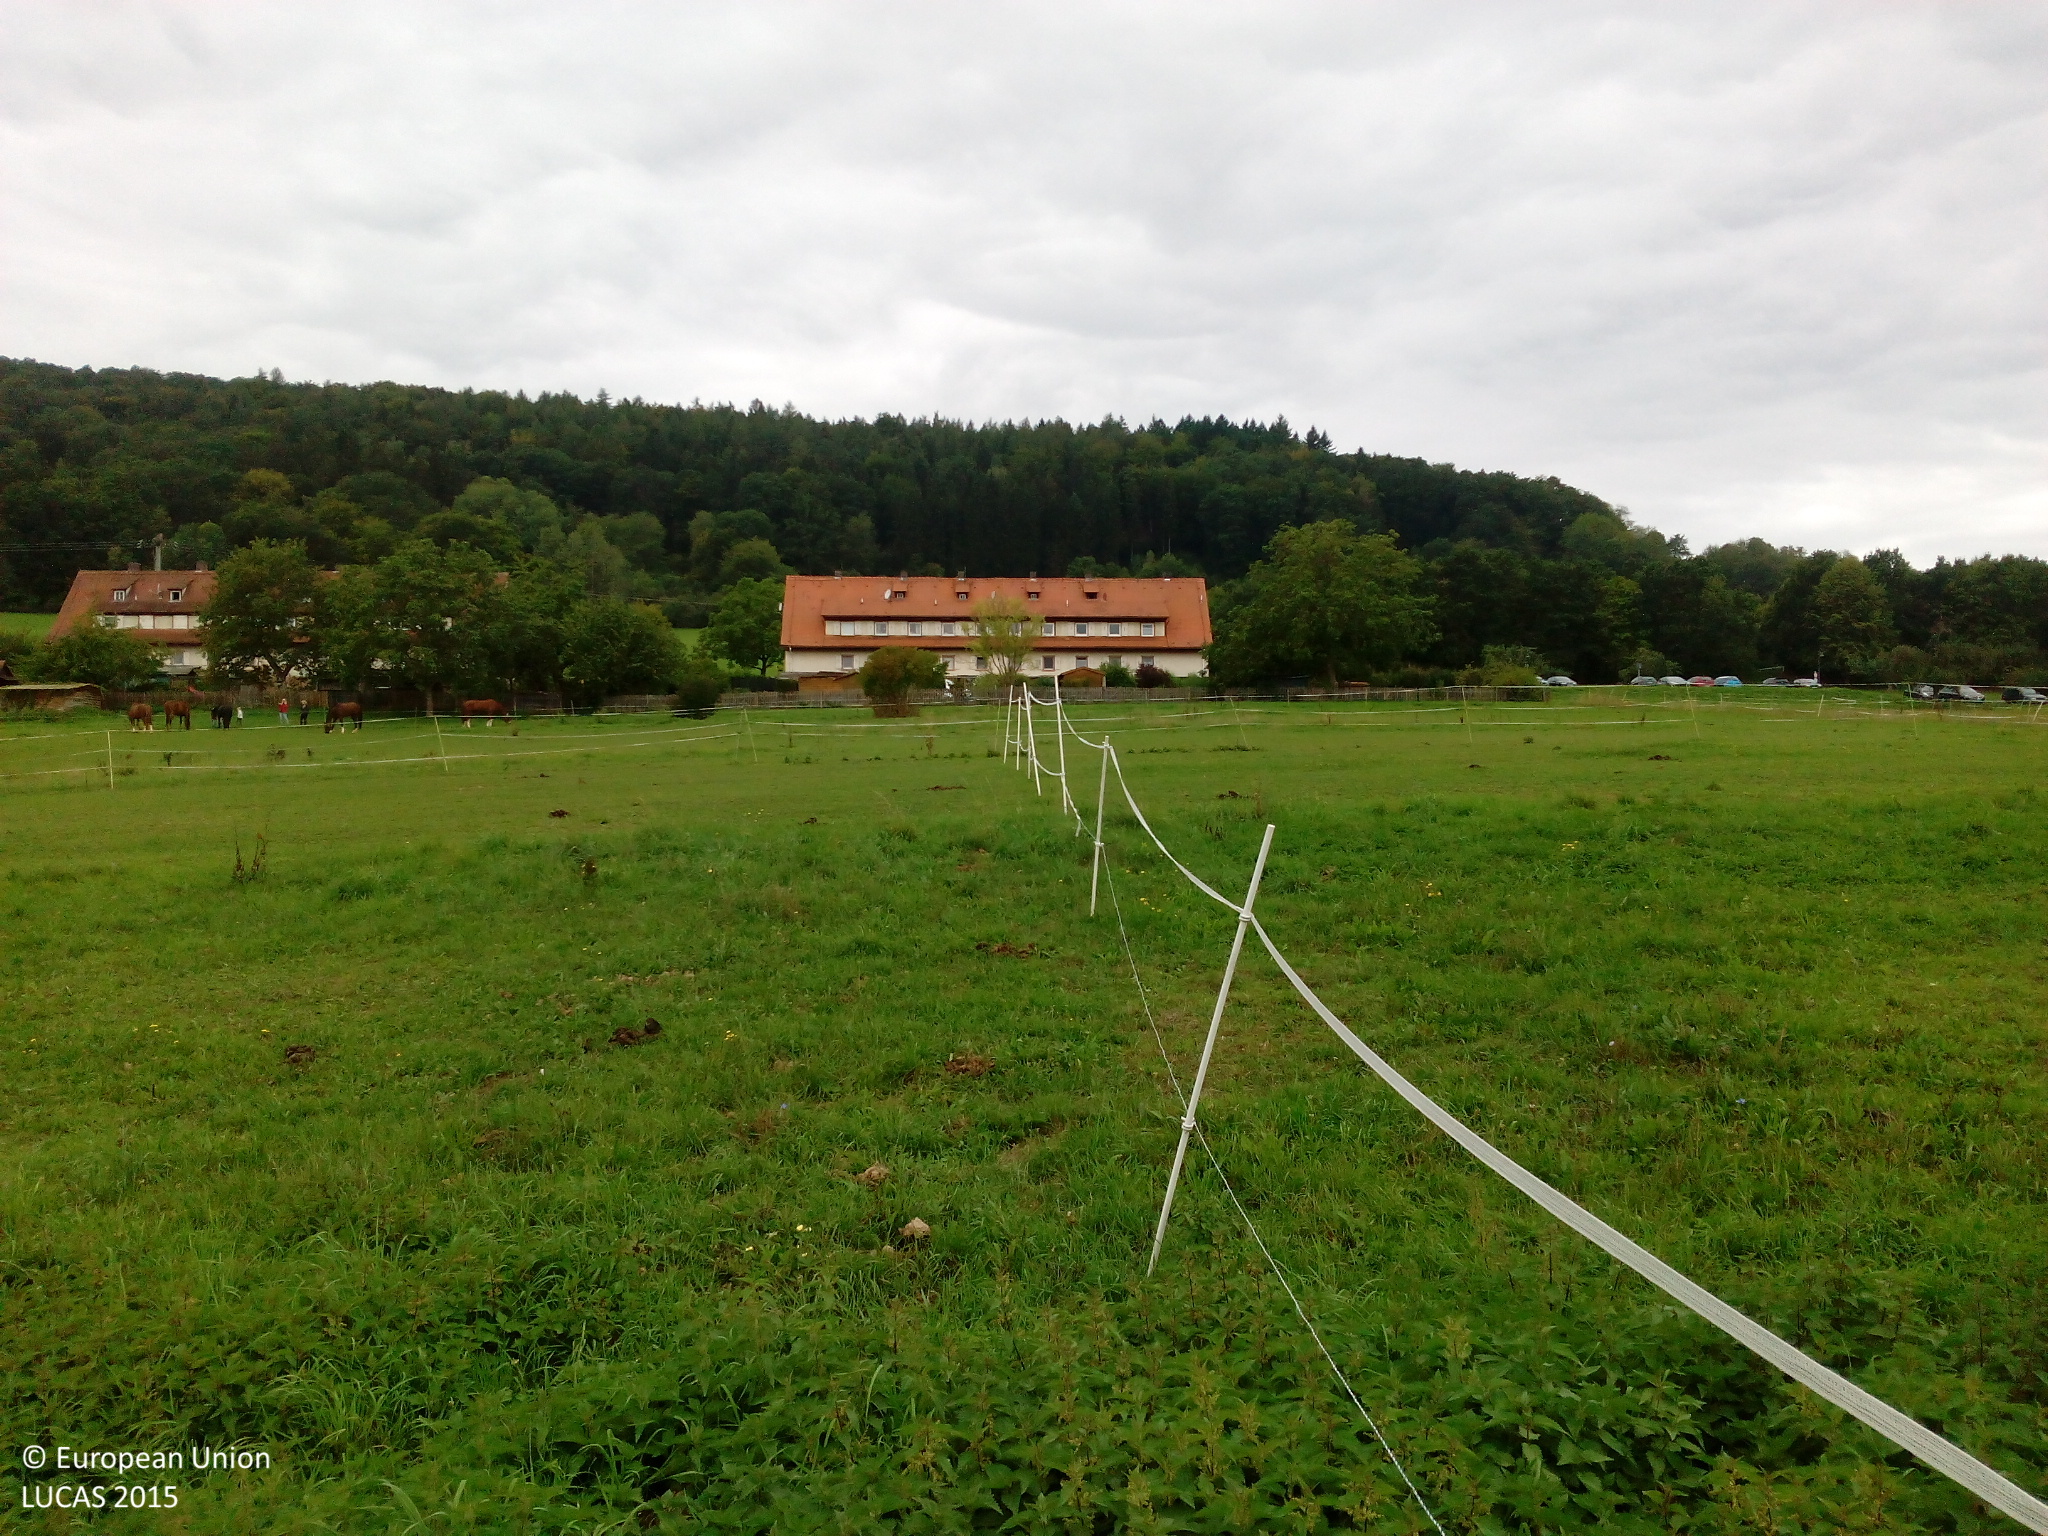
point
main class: Grassland
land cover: Grassland without tree/shrub cover
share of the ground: > 75 %
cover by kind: herbaceous plants 80 %, unconsolidated bare surface 20 %
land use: Agriculture (excluding fallow land and kitchen gardens)
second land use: Amenities, museums, leisure
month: September
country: DE
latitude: 49.9856
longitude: 9.5678
